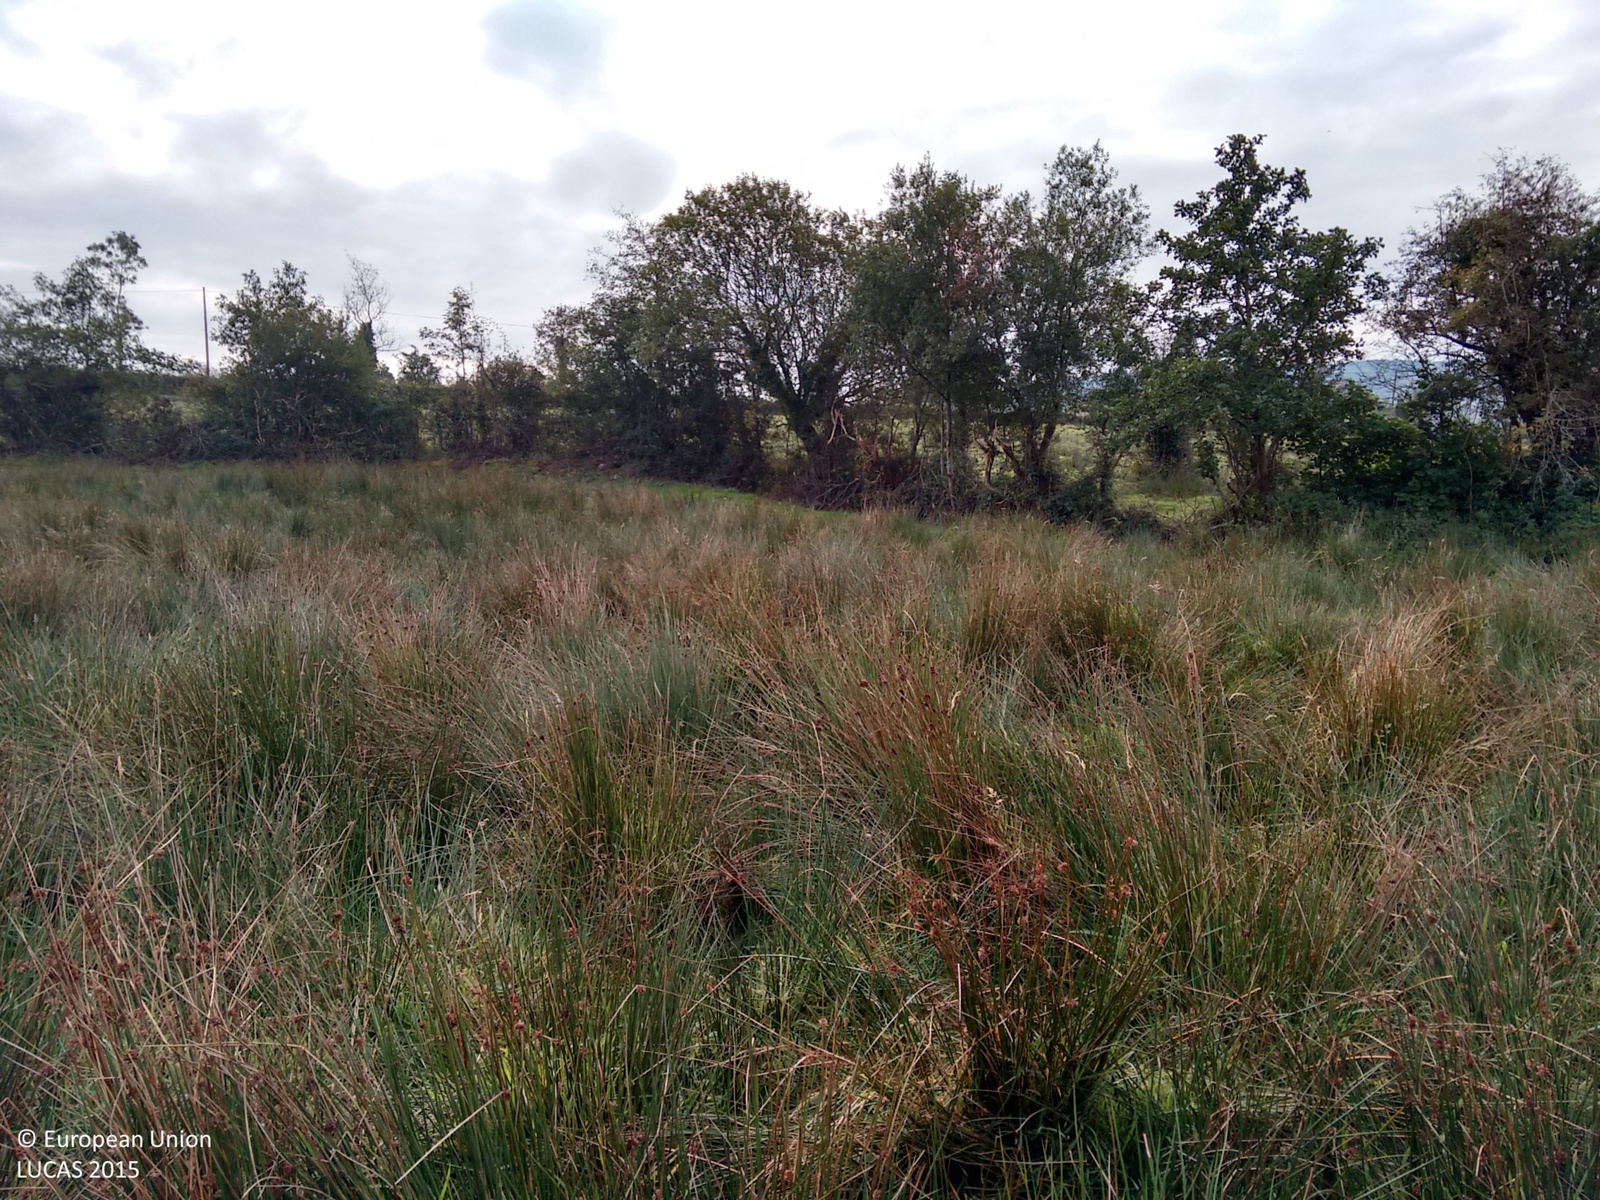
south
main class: Grassland
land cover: Grassland without tree/shrub cover
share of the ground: > 75 %
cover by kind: herbaceous plants 100 %
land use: Agriculture (excluding fallow land and kitchen gardens)
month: October
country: GB
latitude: 54.3571
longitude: -7.7848
